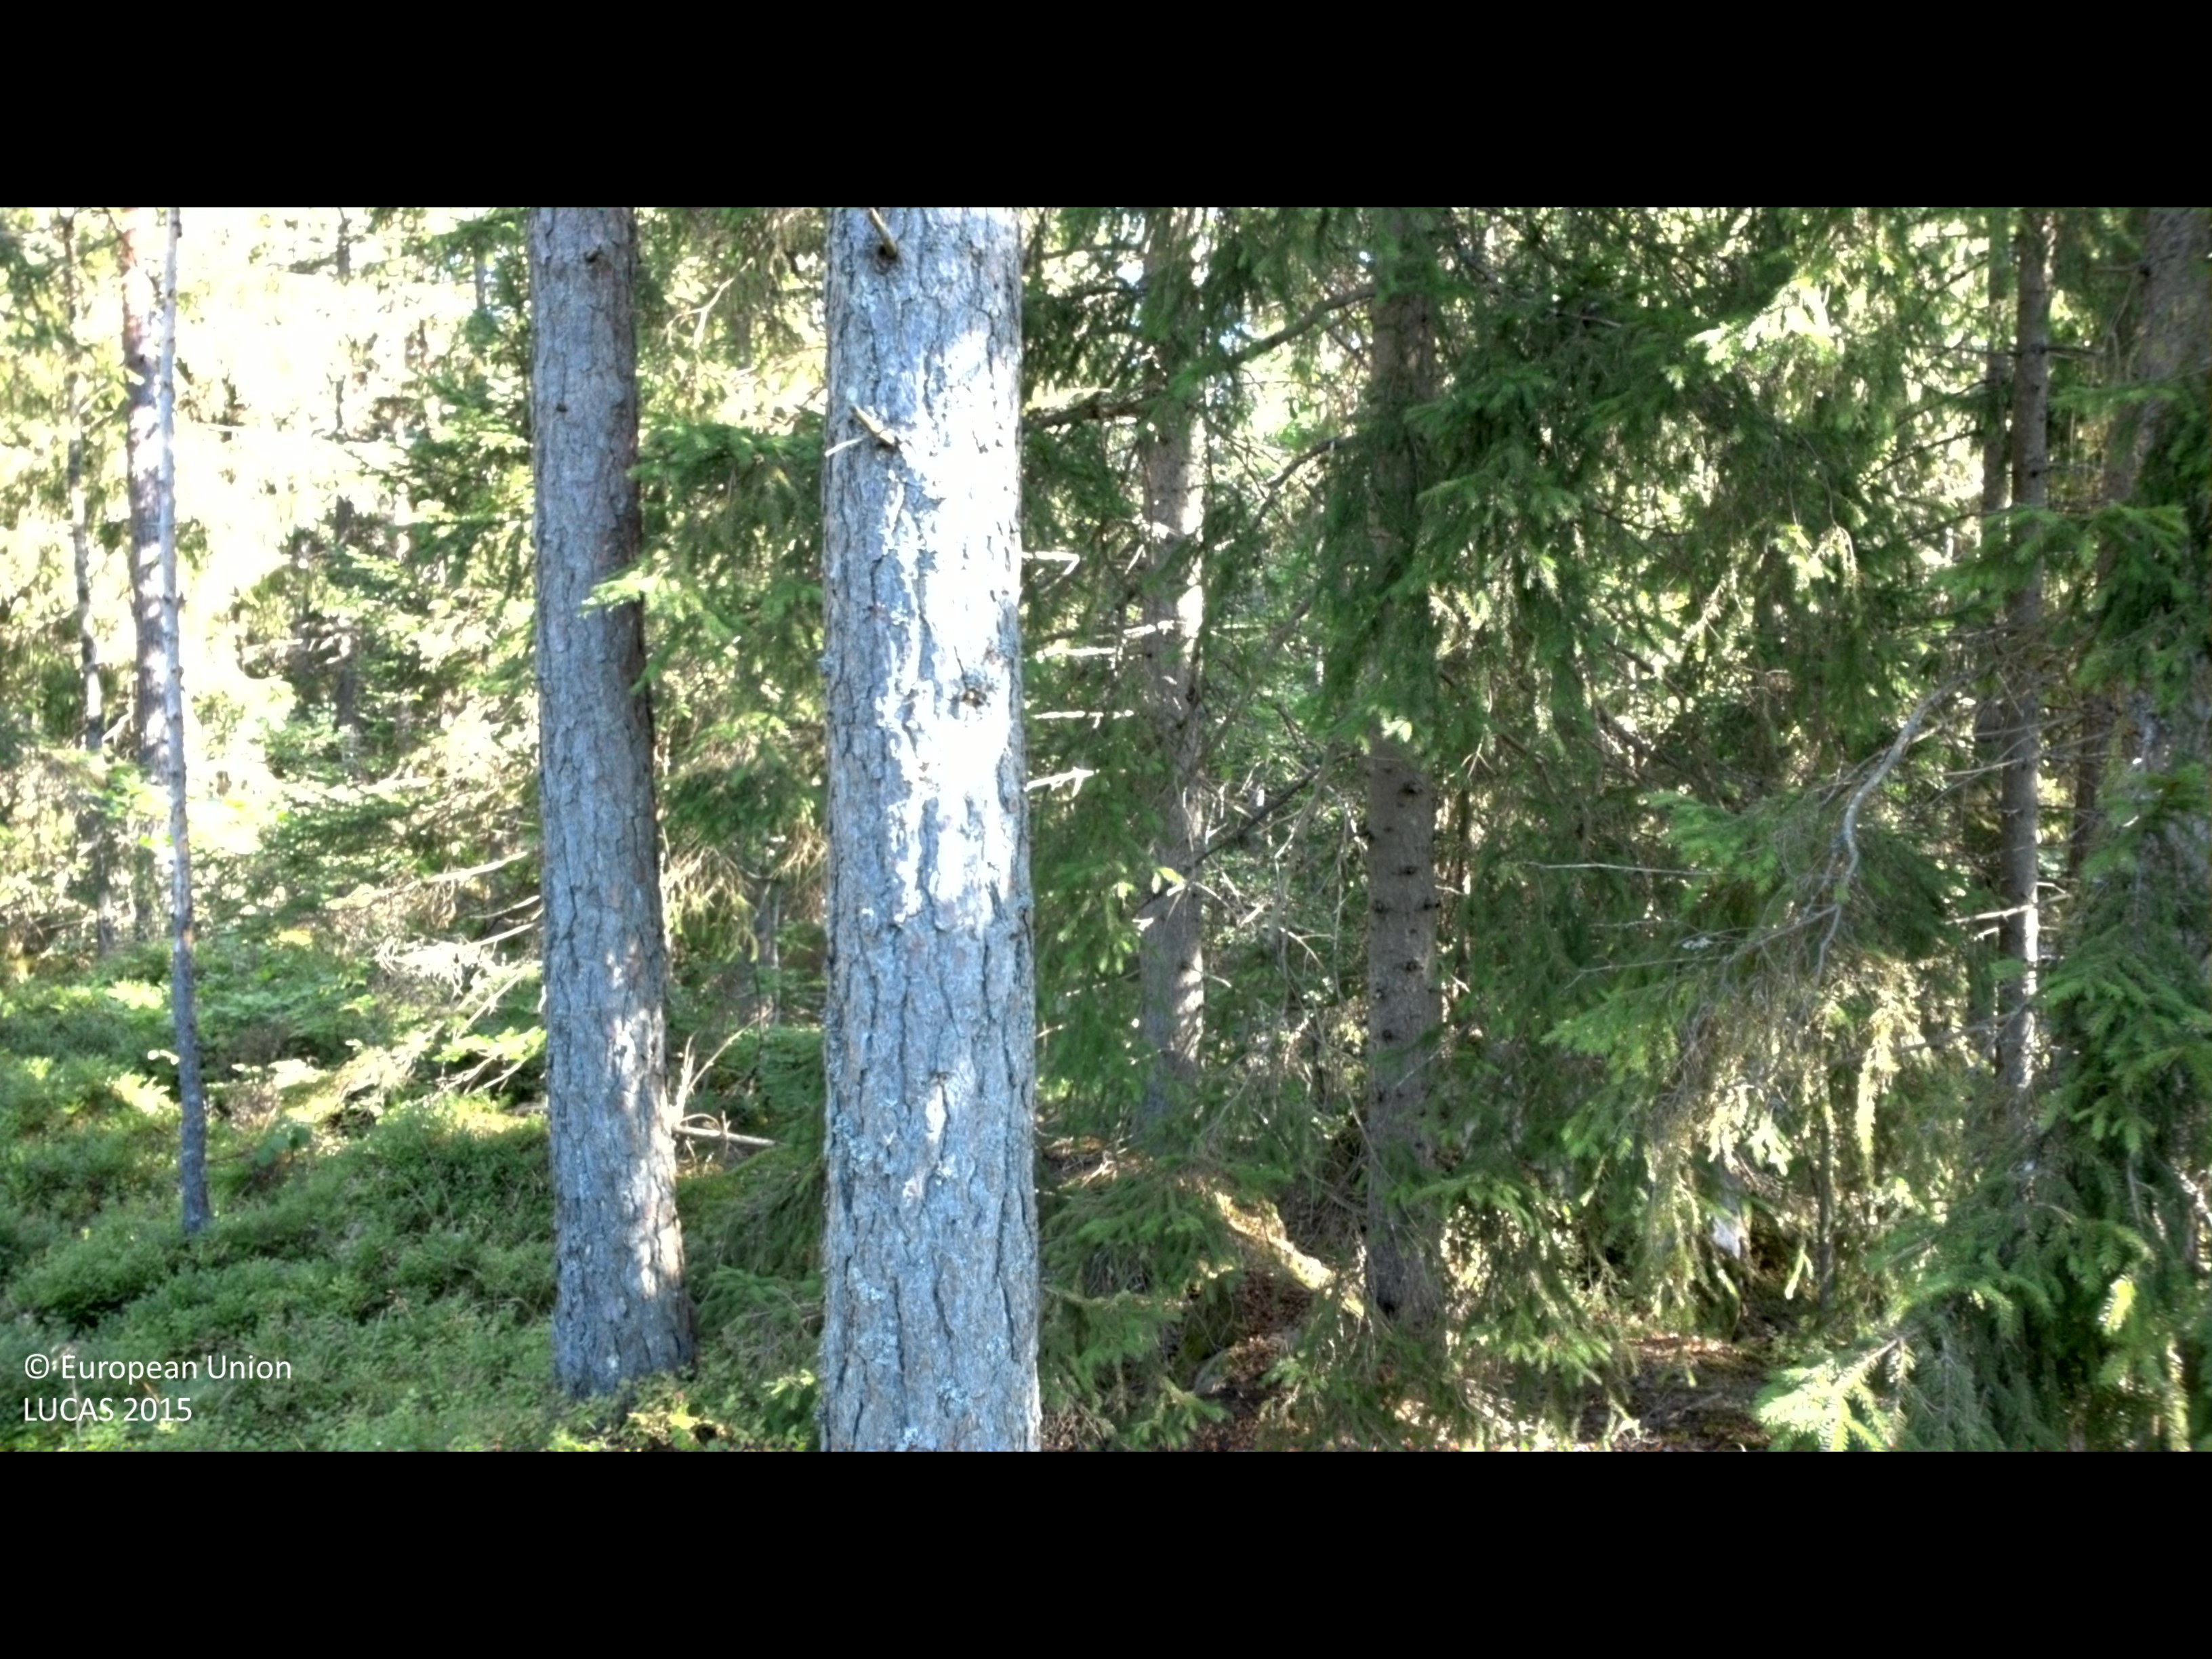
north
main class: Woodland
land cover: Other coniferous woodland
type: boreal forest
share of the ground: > 75 %
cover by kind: coniferous forest trees 75 %, shrubs 20 %, lichens and mosses 5 %
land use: Forestry
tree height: > 5 m
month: August
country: SE
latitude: 56.3154
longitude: 14.7673
